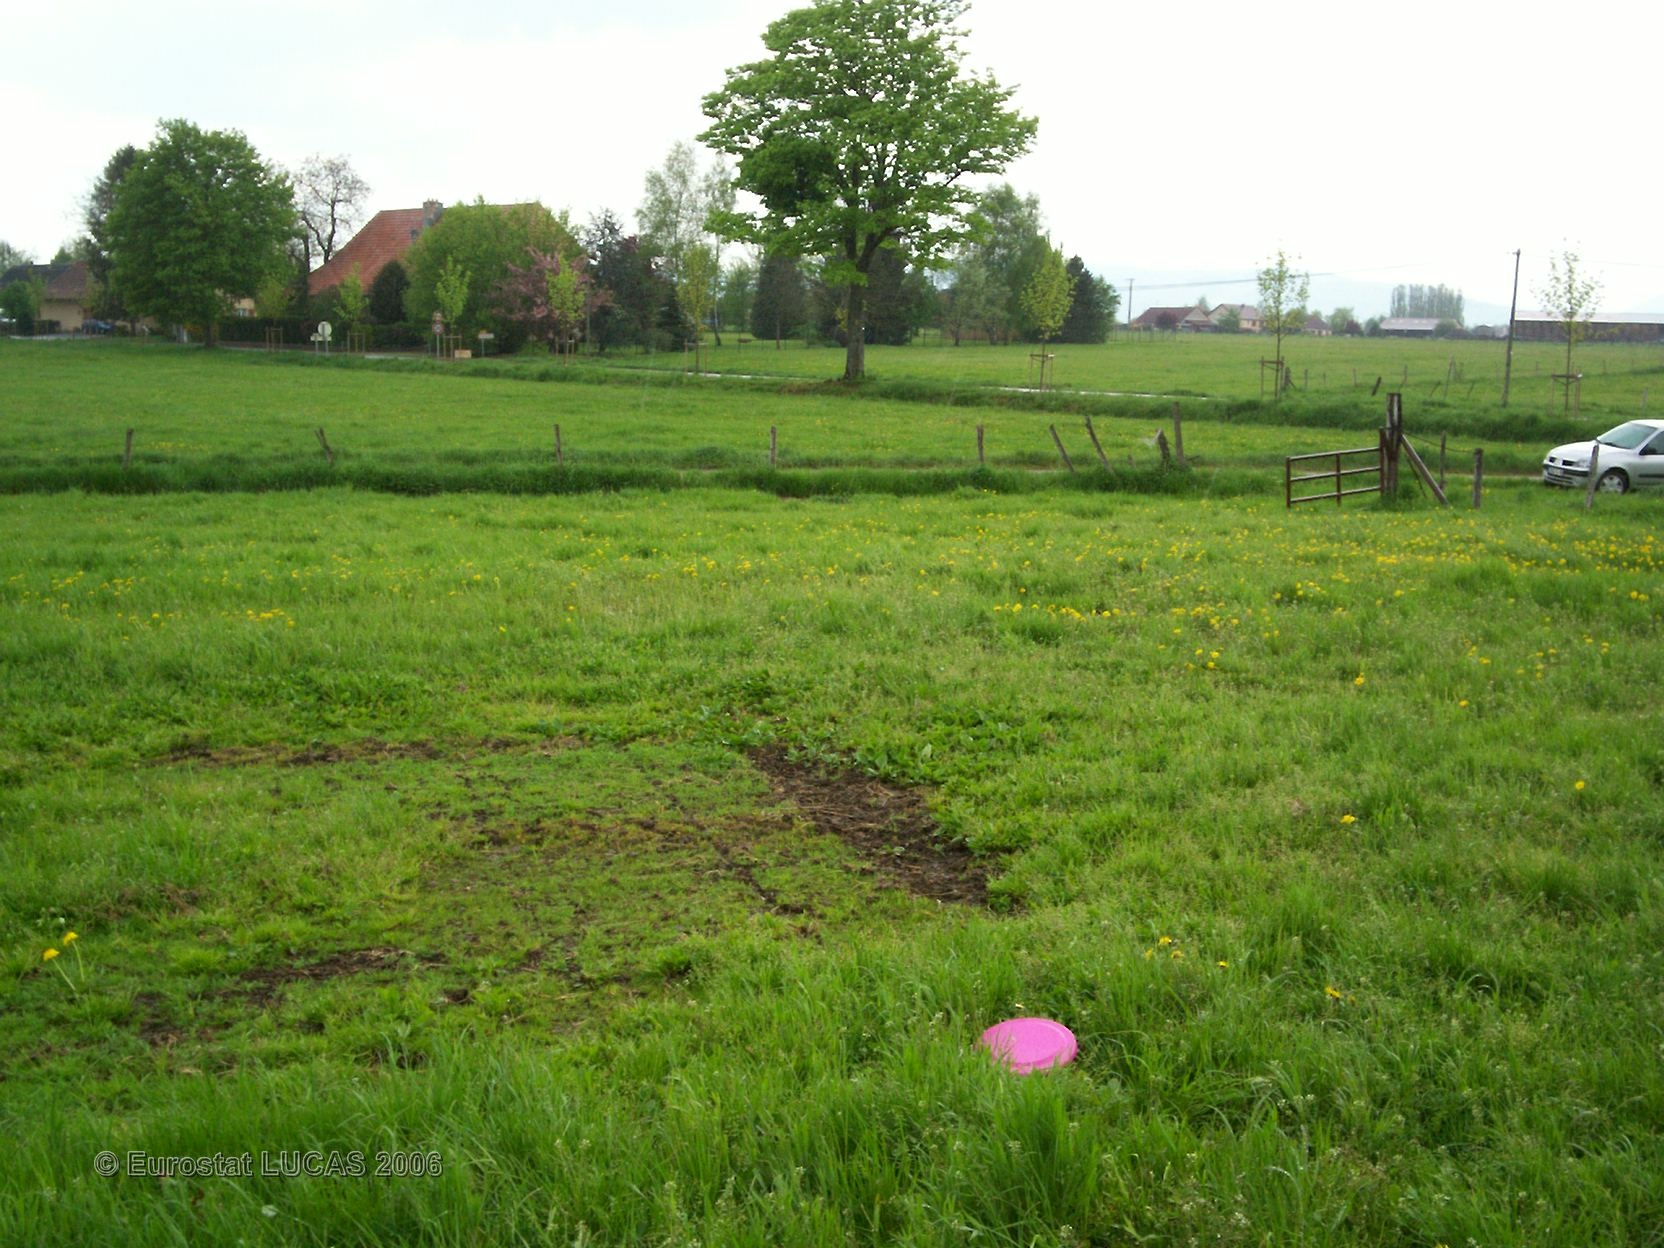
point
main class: Grassland
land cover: Grassland without tree/shrub cover
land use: Agriculture (excluding fallow land and kitchen gardens)
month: May
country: FR
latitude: 47.6606
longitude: 7.0055
